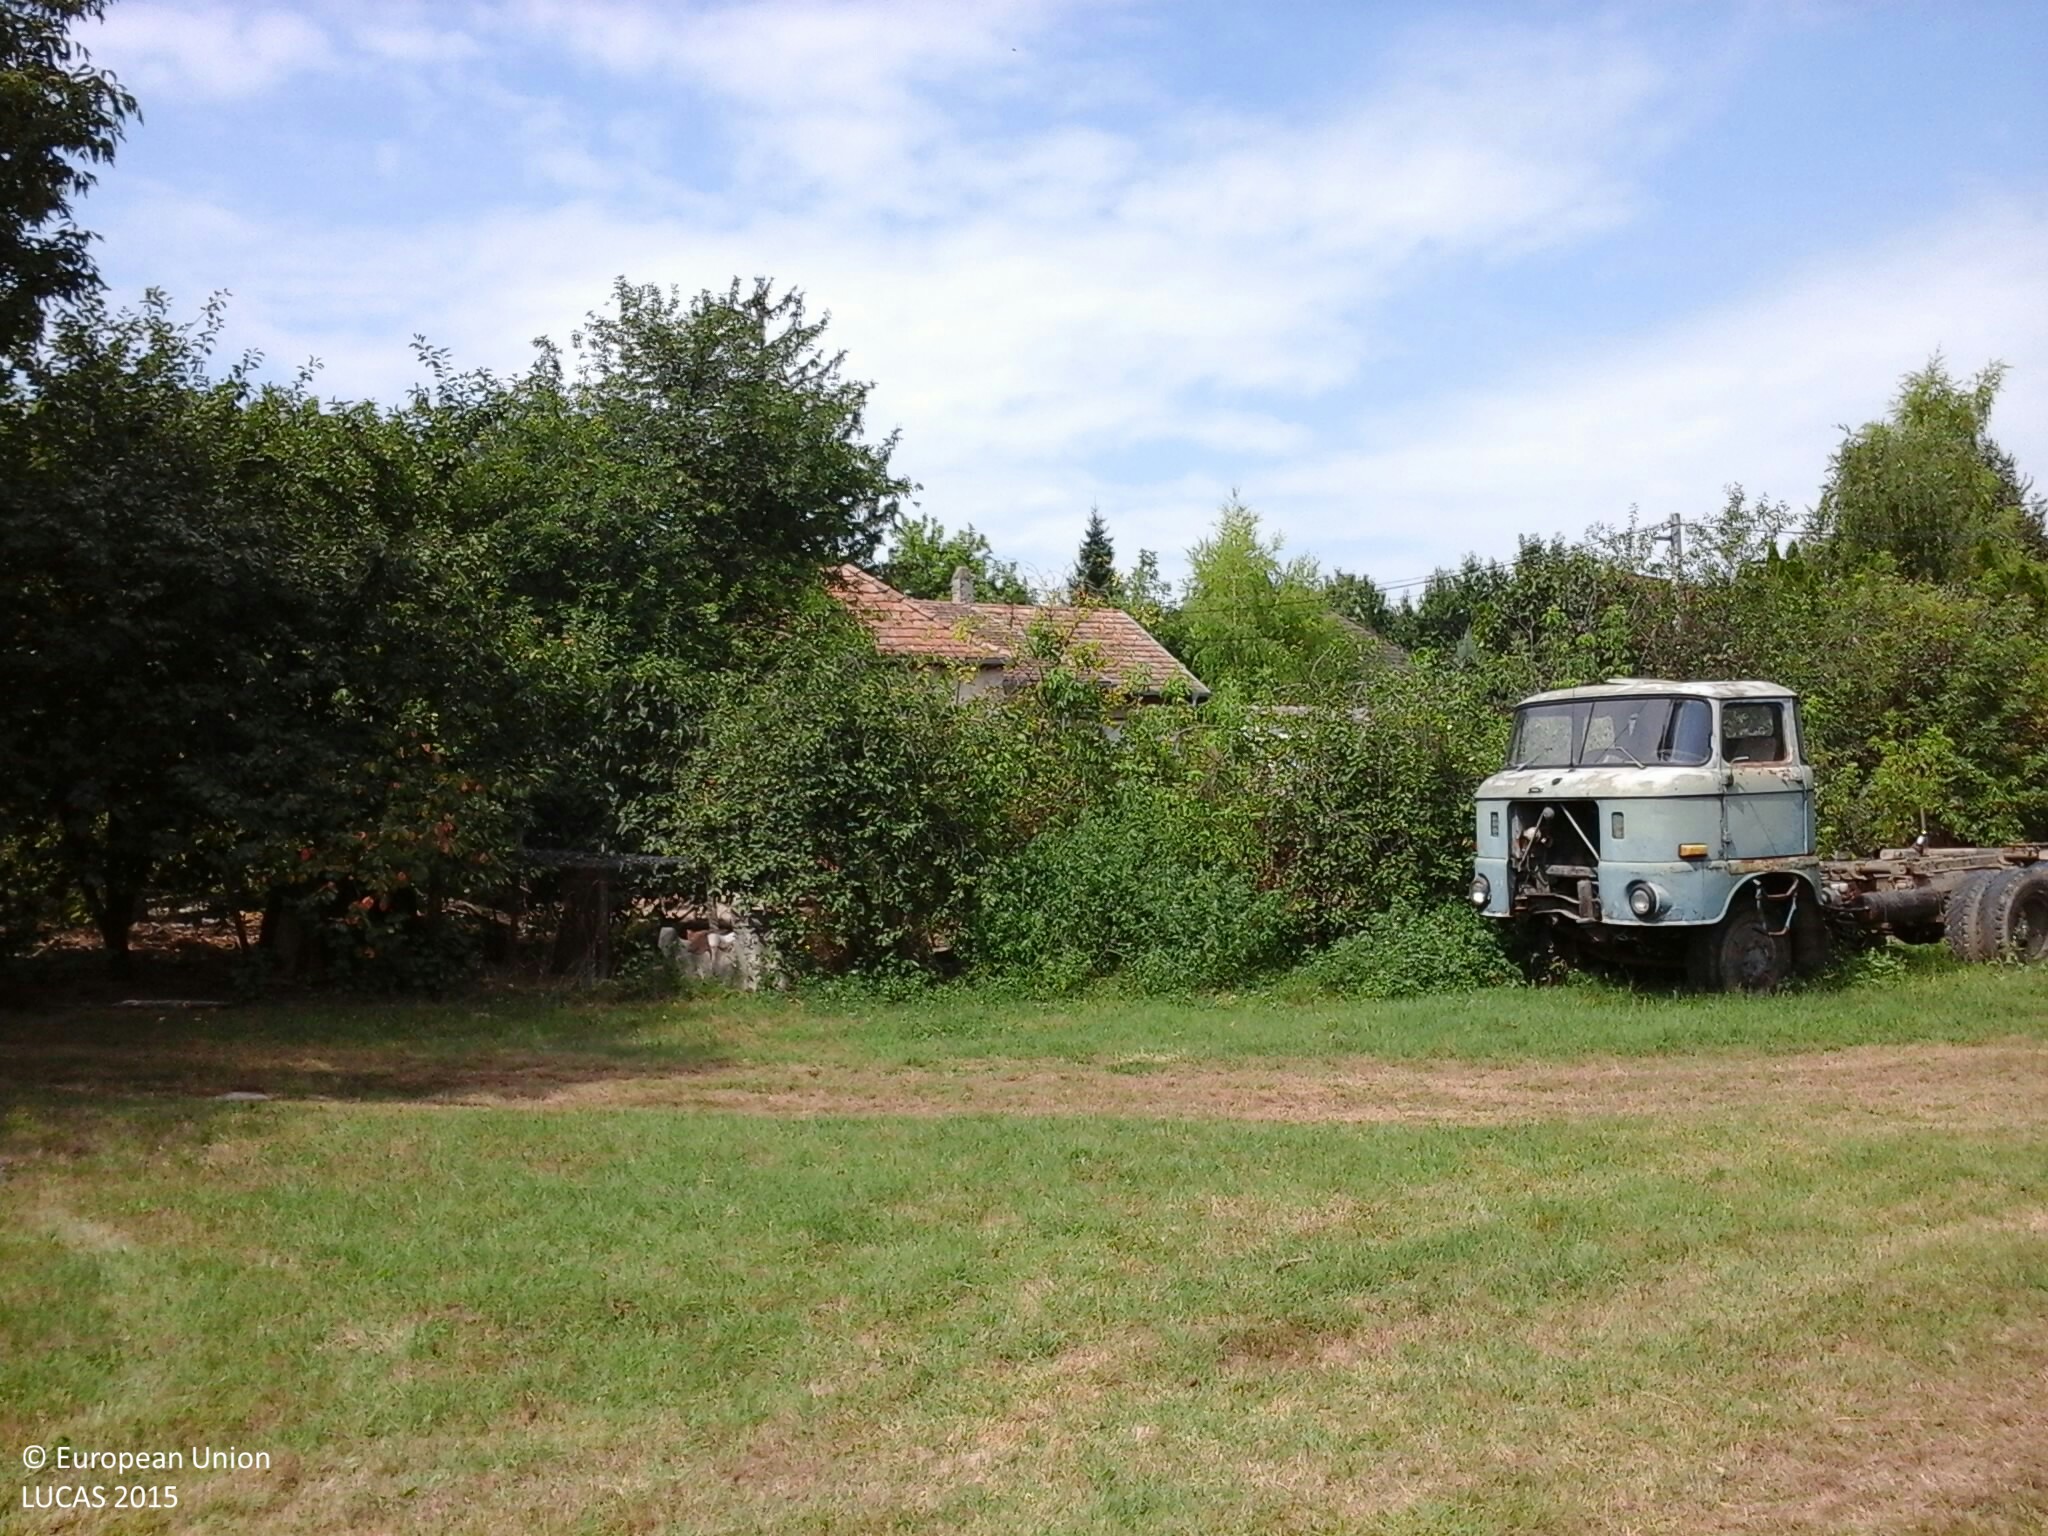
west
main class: Grassland
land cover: Grassland without tree/shrub cover
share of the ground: > 75 %
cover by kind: herbaceous plants 100 %
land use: Agriculture (excluding fallow land and kitchen gardens)
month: August
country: HU
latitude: 46.8975
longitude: 18.0554
